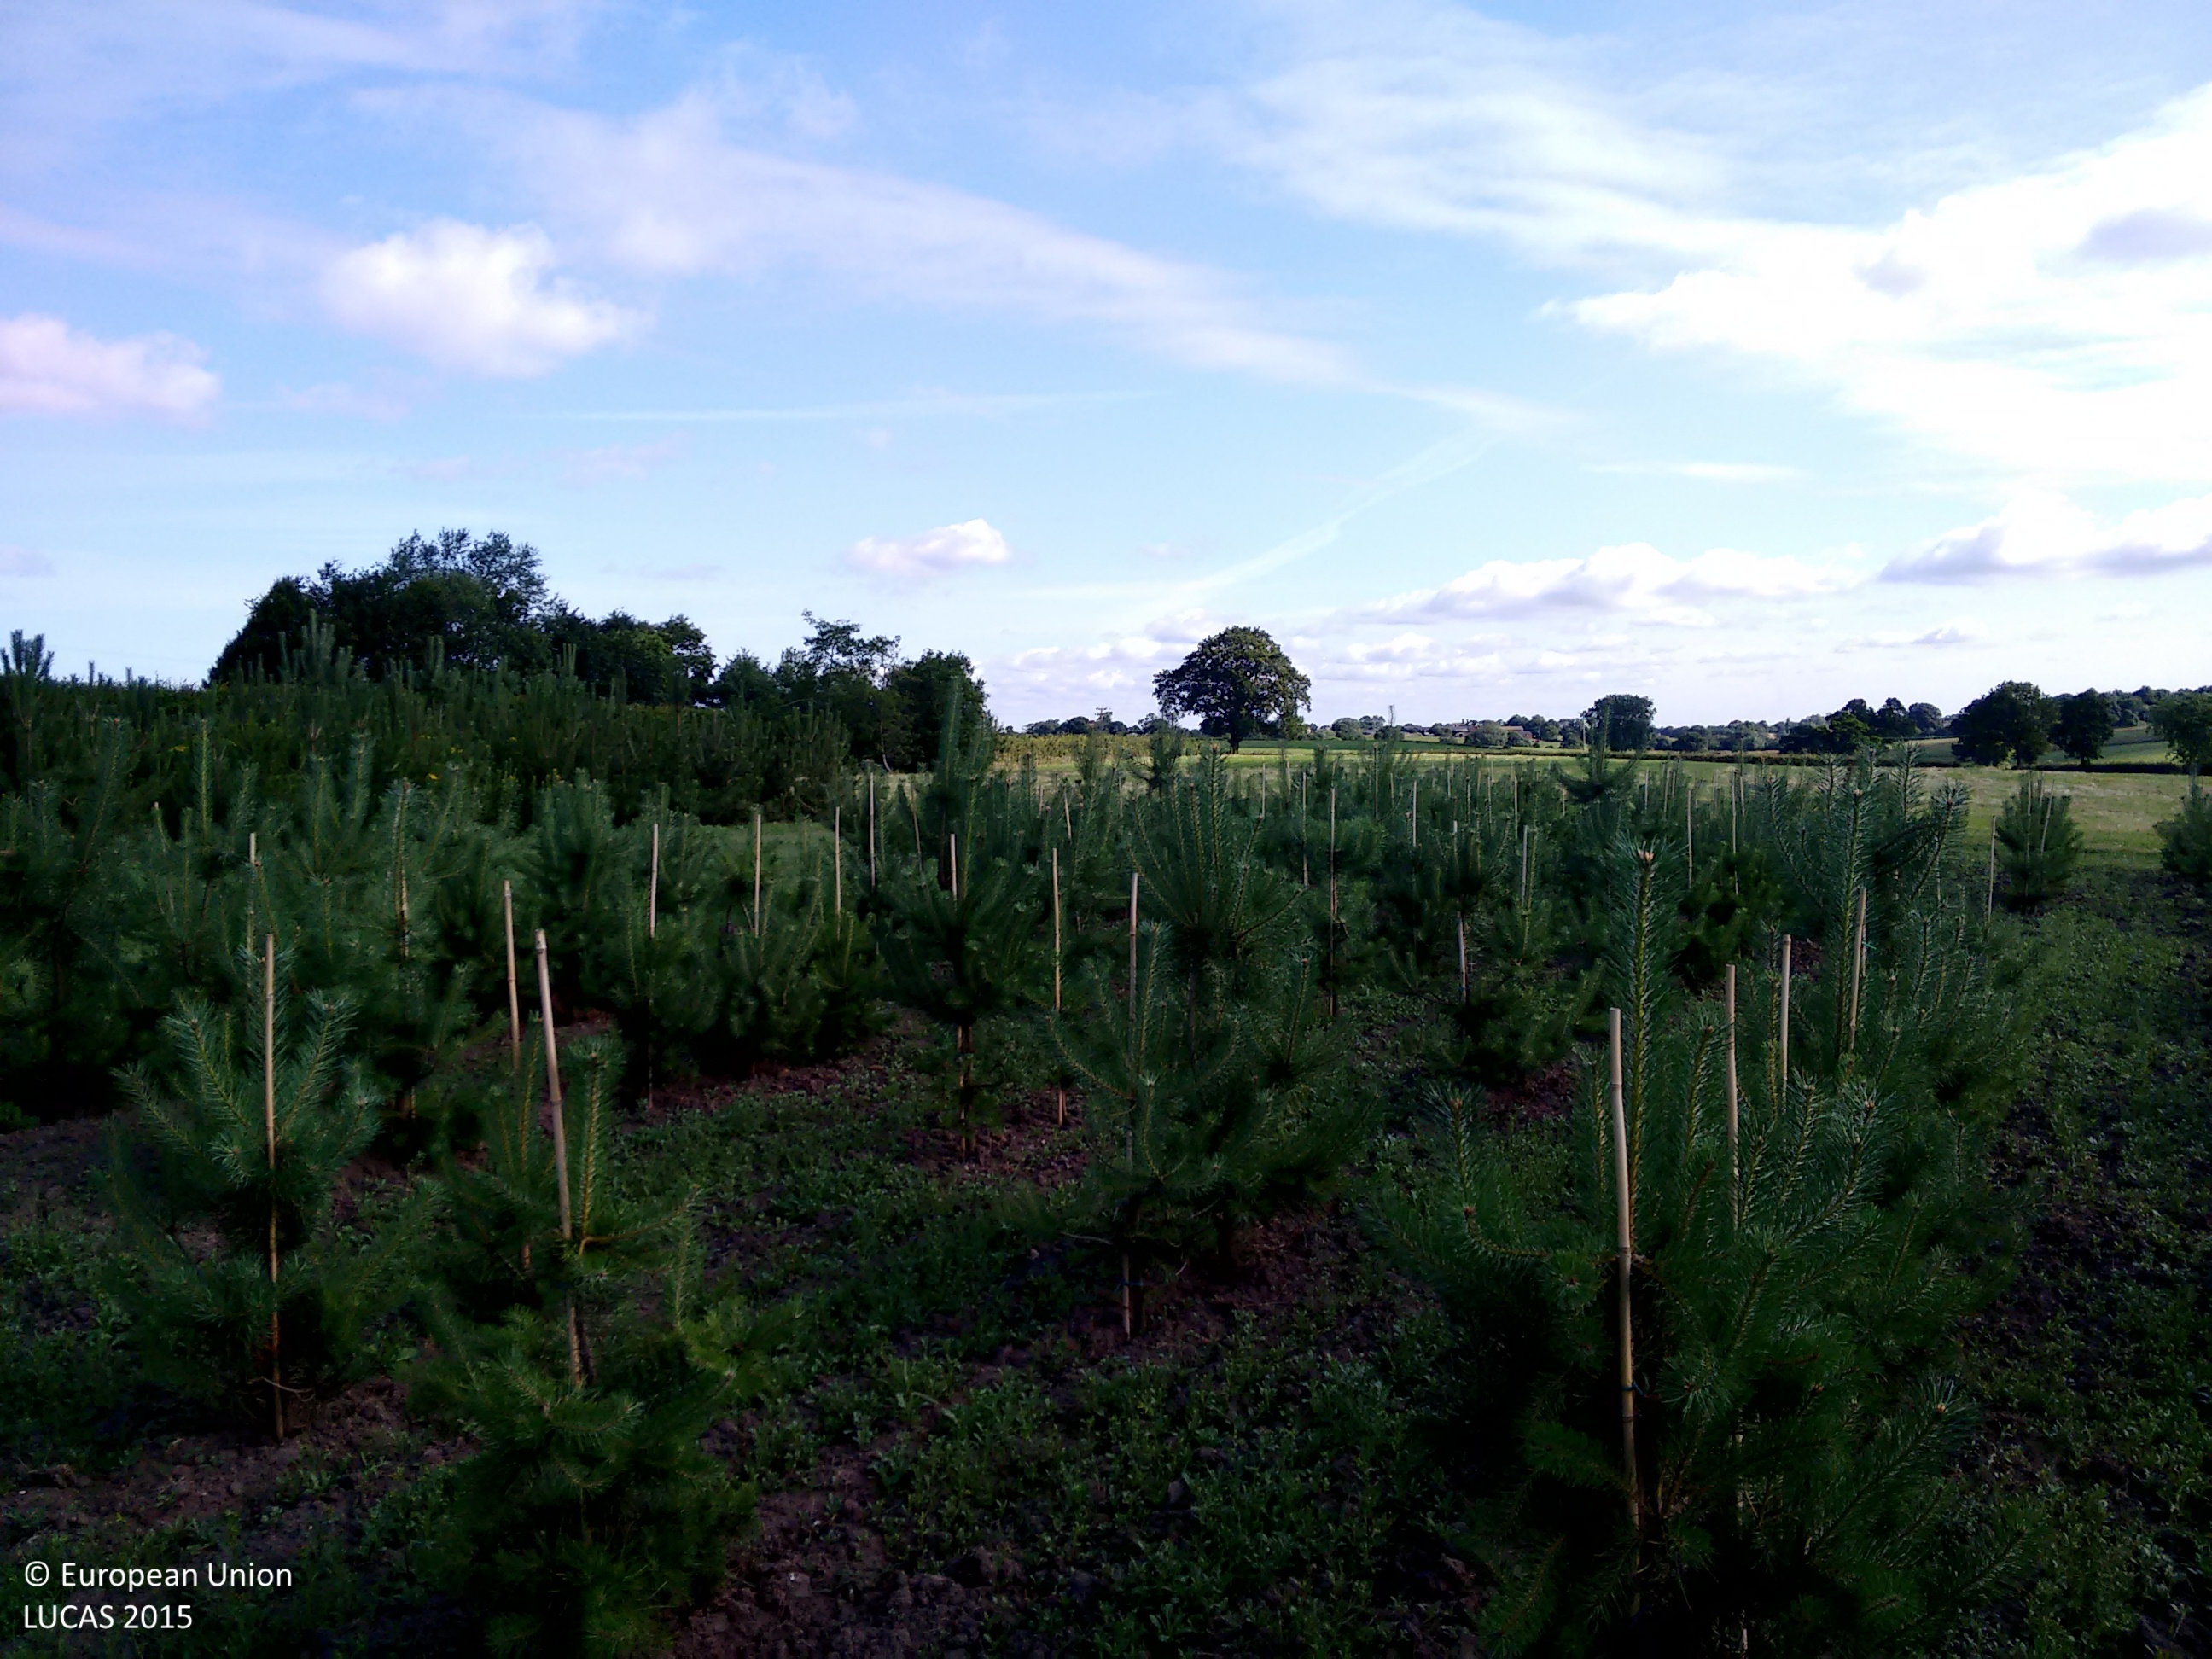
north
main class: Cropland
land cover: Nurseries
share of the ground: > 75 %
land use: Agriculture (excluding fallow land and kitchen gardens)
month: July
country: GB
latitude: 53.1177
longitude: -2.2995
